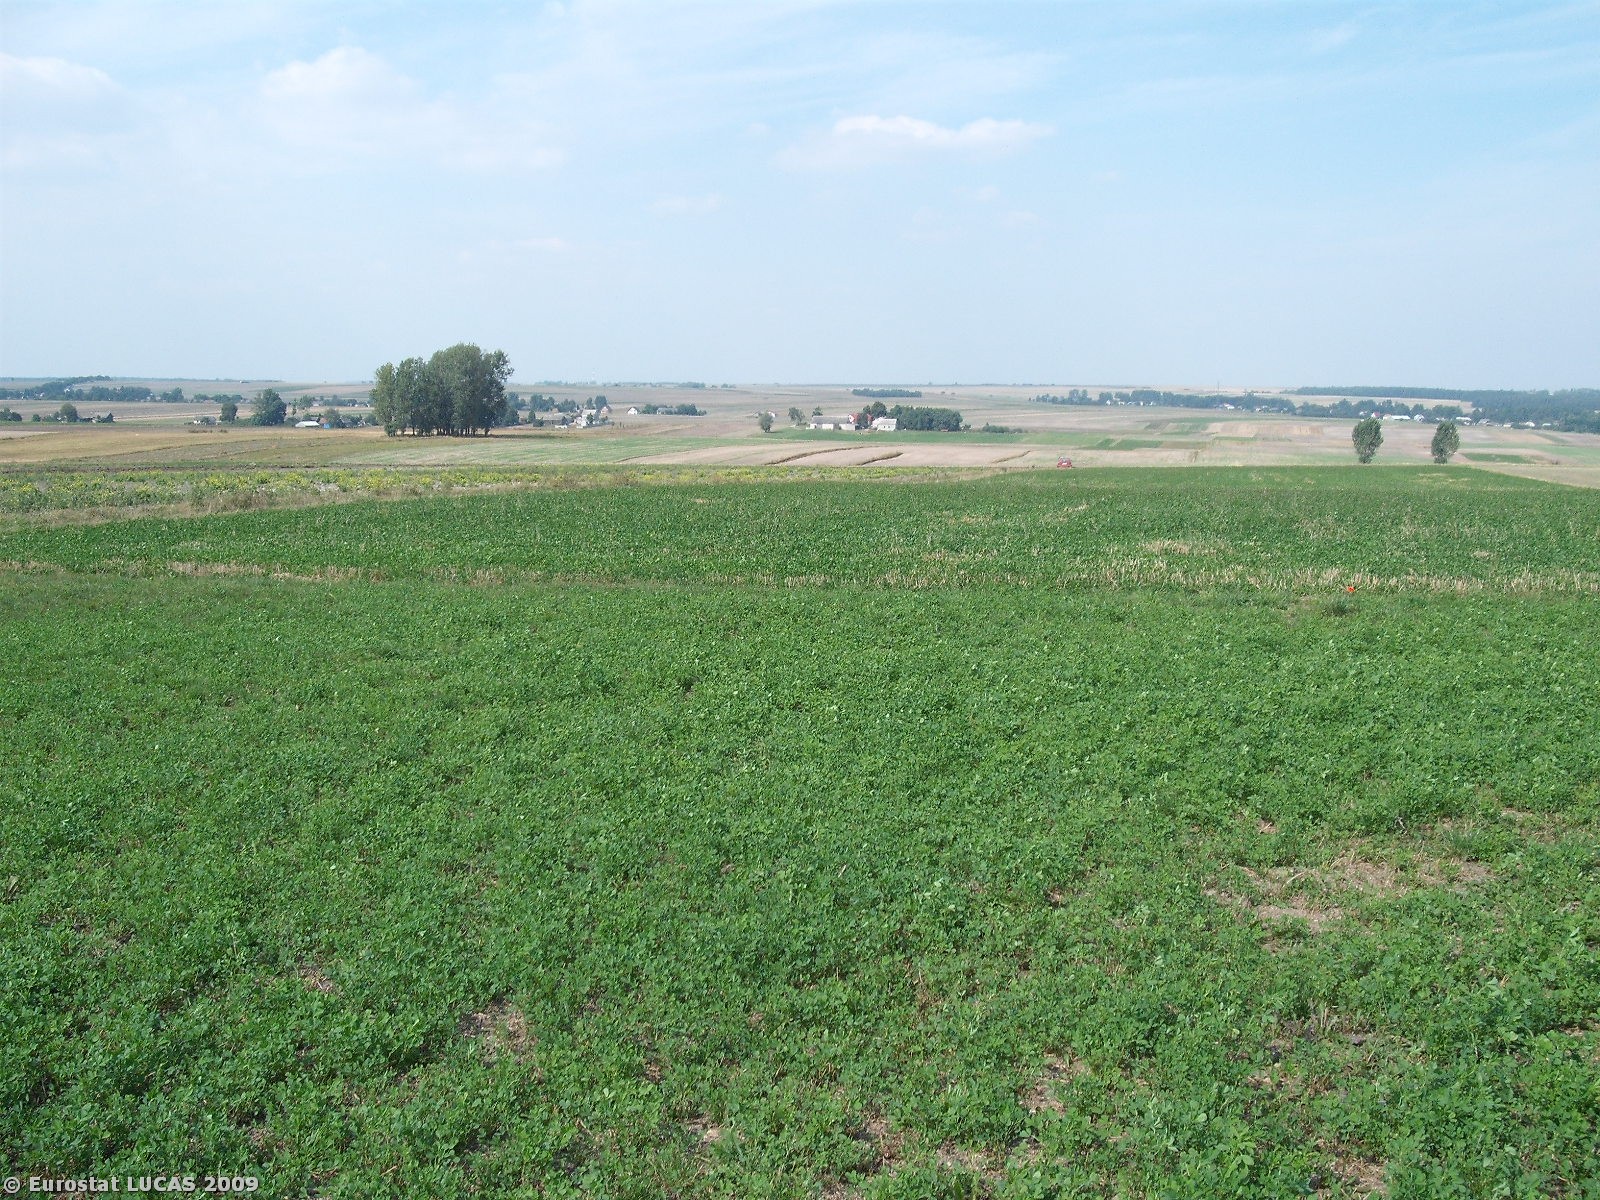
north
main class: Cropland
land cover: Lucerne
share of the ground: > 75 %
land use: Agriculture (excluding fallow land and kitchen gardens)
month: September
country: PL
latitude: 50.5457
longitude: 20.3522
